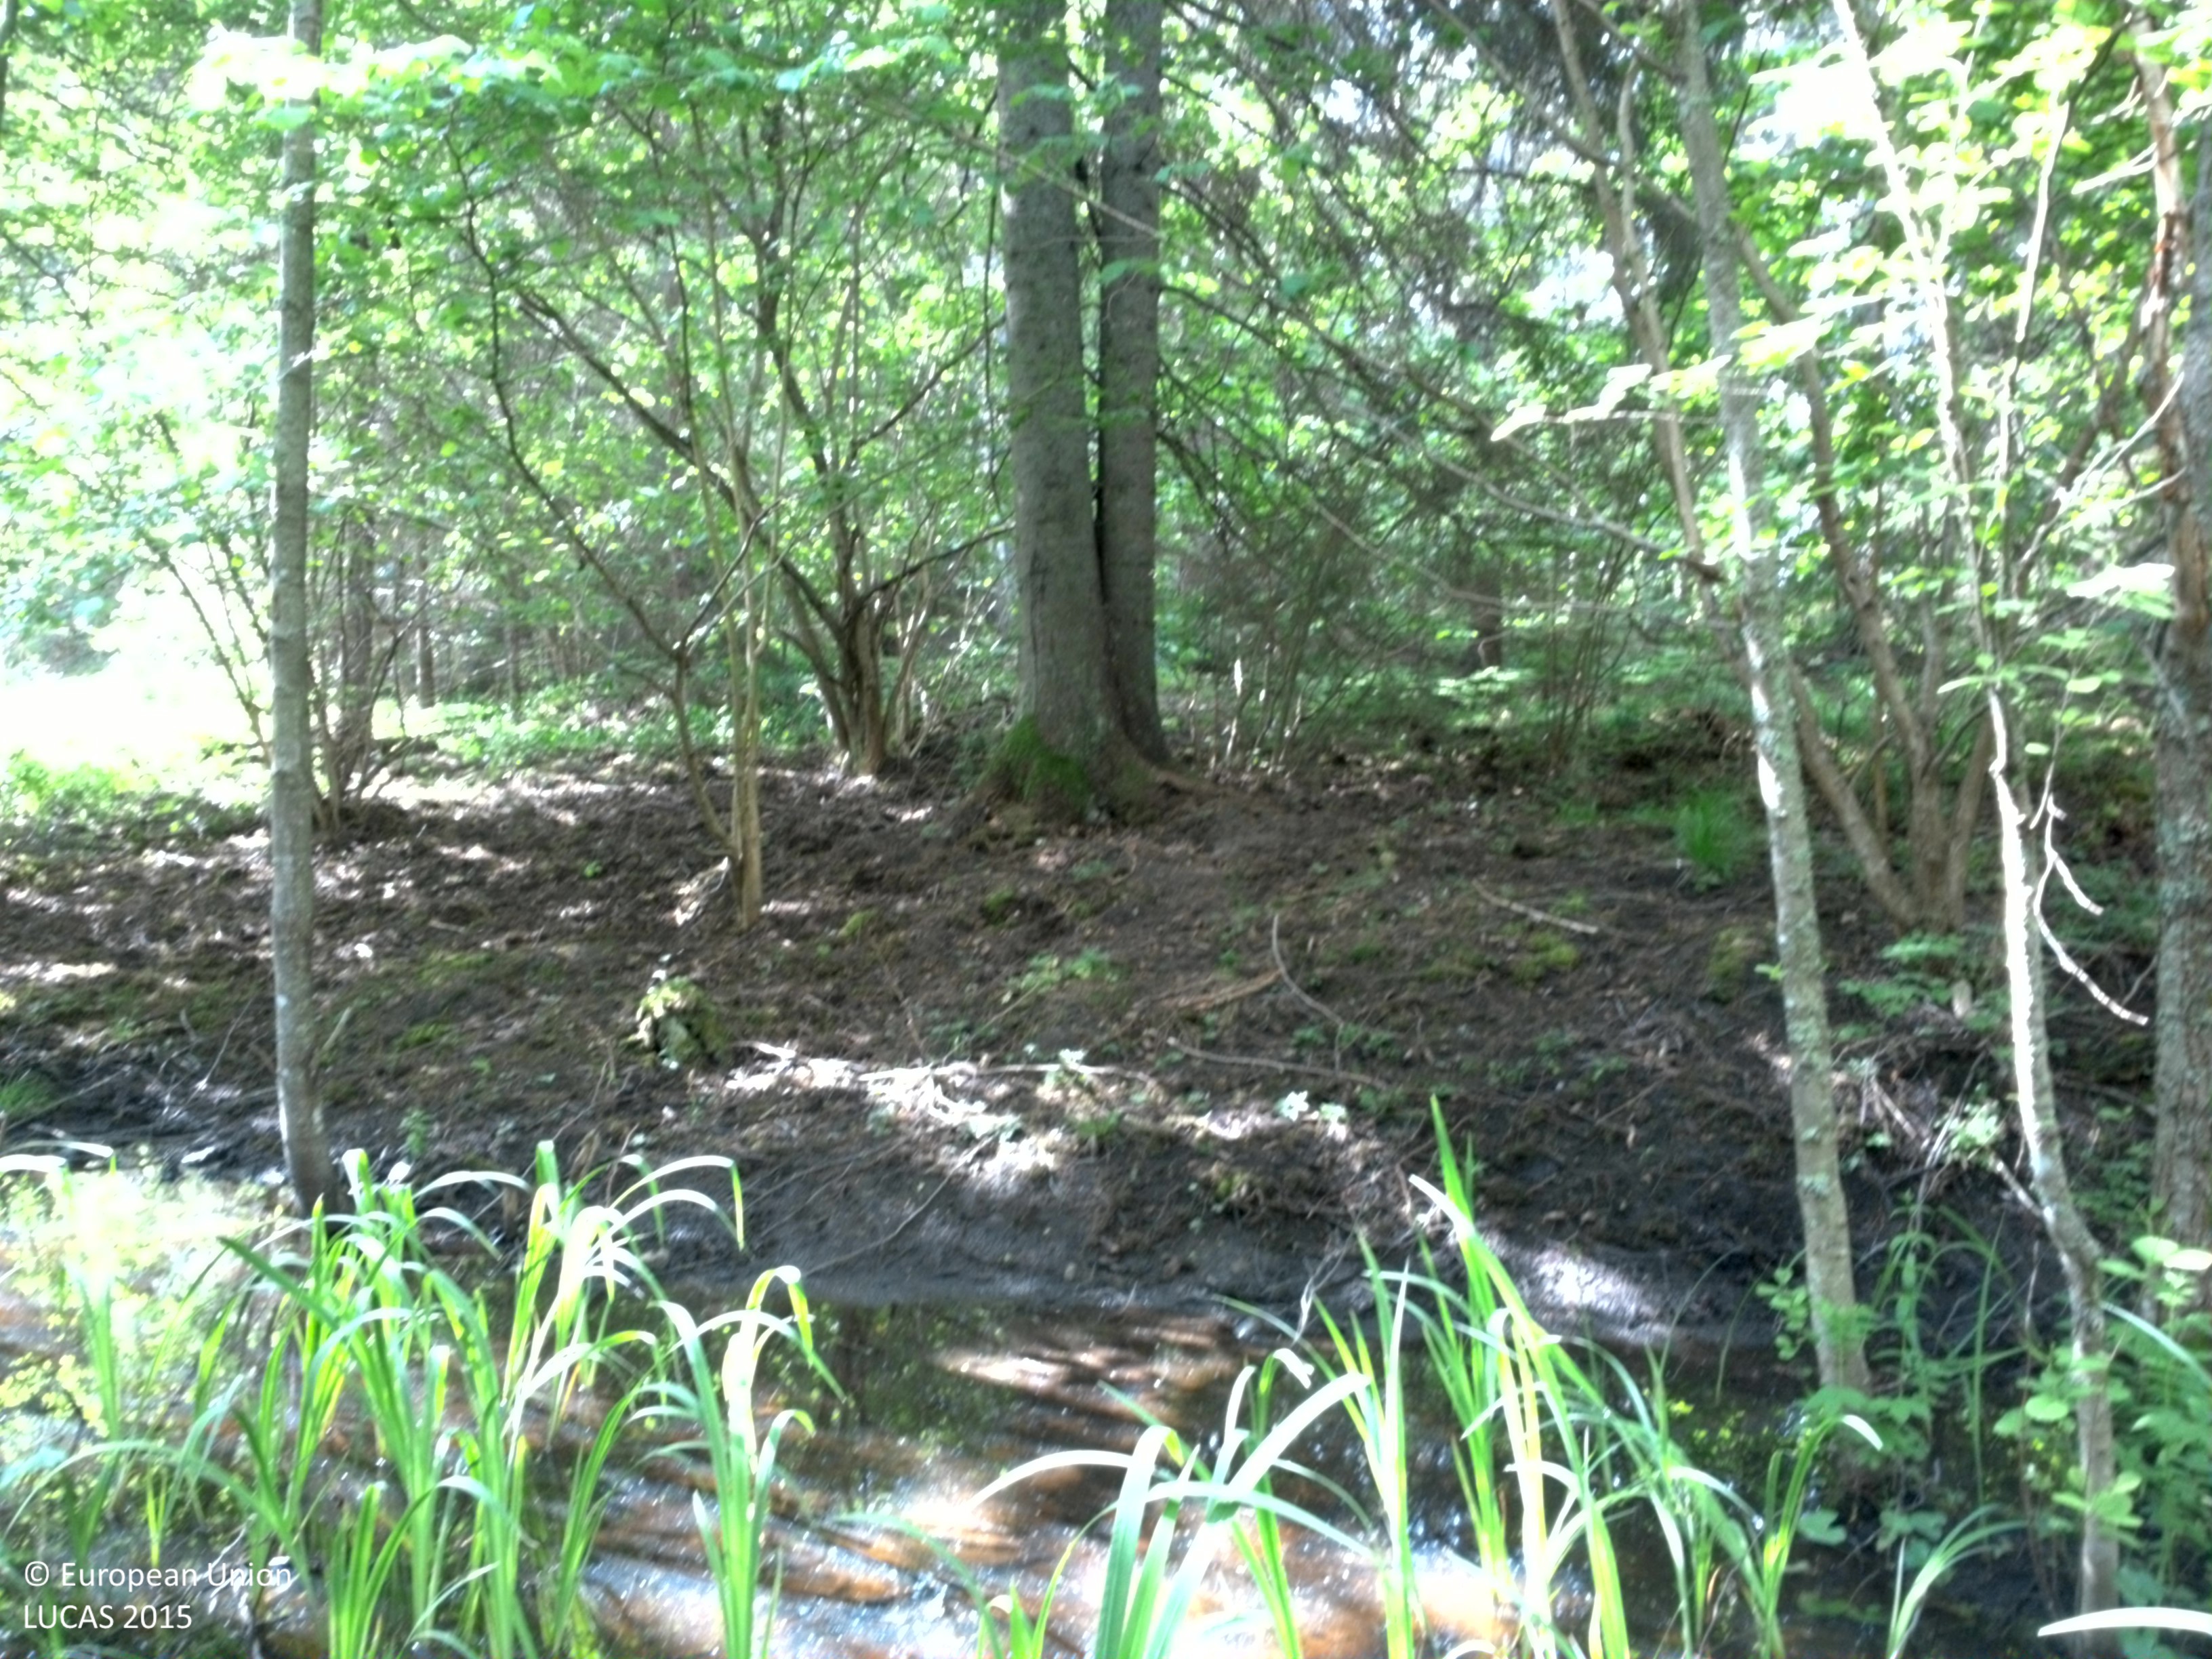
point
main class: Woodland
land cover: Spruce dominated mixed woodland
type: boreal forest
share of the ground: > 75 %
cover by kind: coniferous forest trees 60 %, broadleaved forest trees 20 %, herbaceous plants 10 %, lichens and mosses 10 %
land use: Forestry
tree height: > 5 m
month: June
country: SE
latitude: 60.0895
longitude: 18.7542
